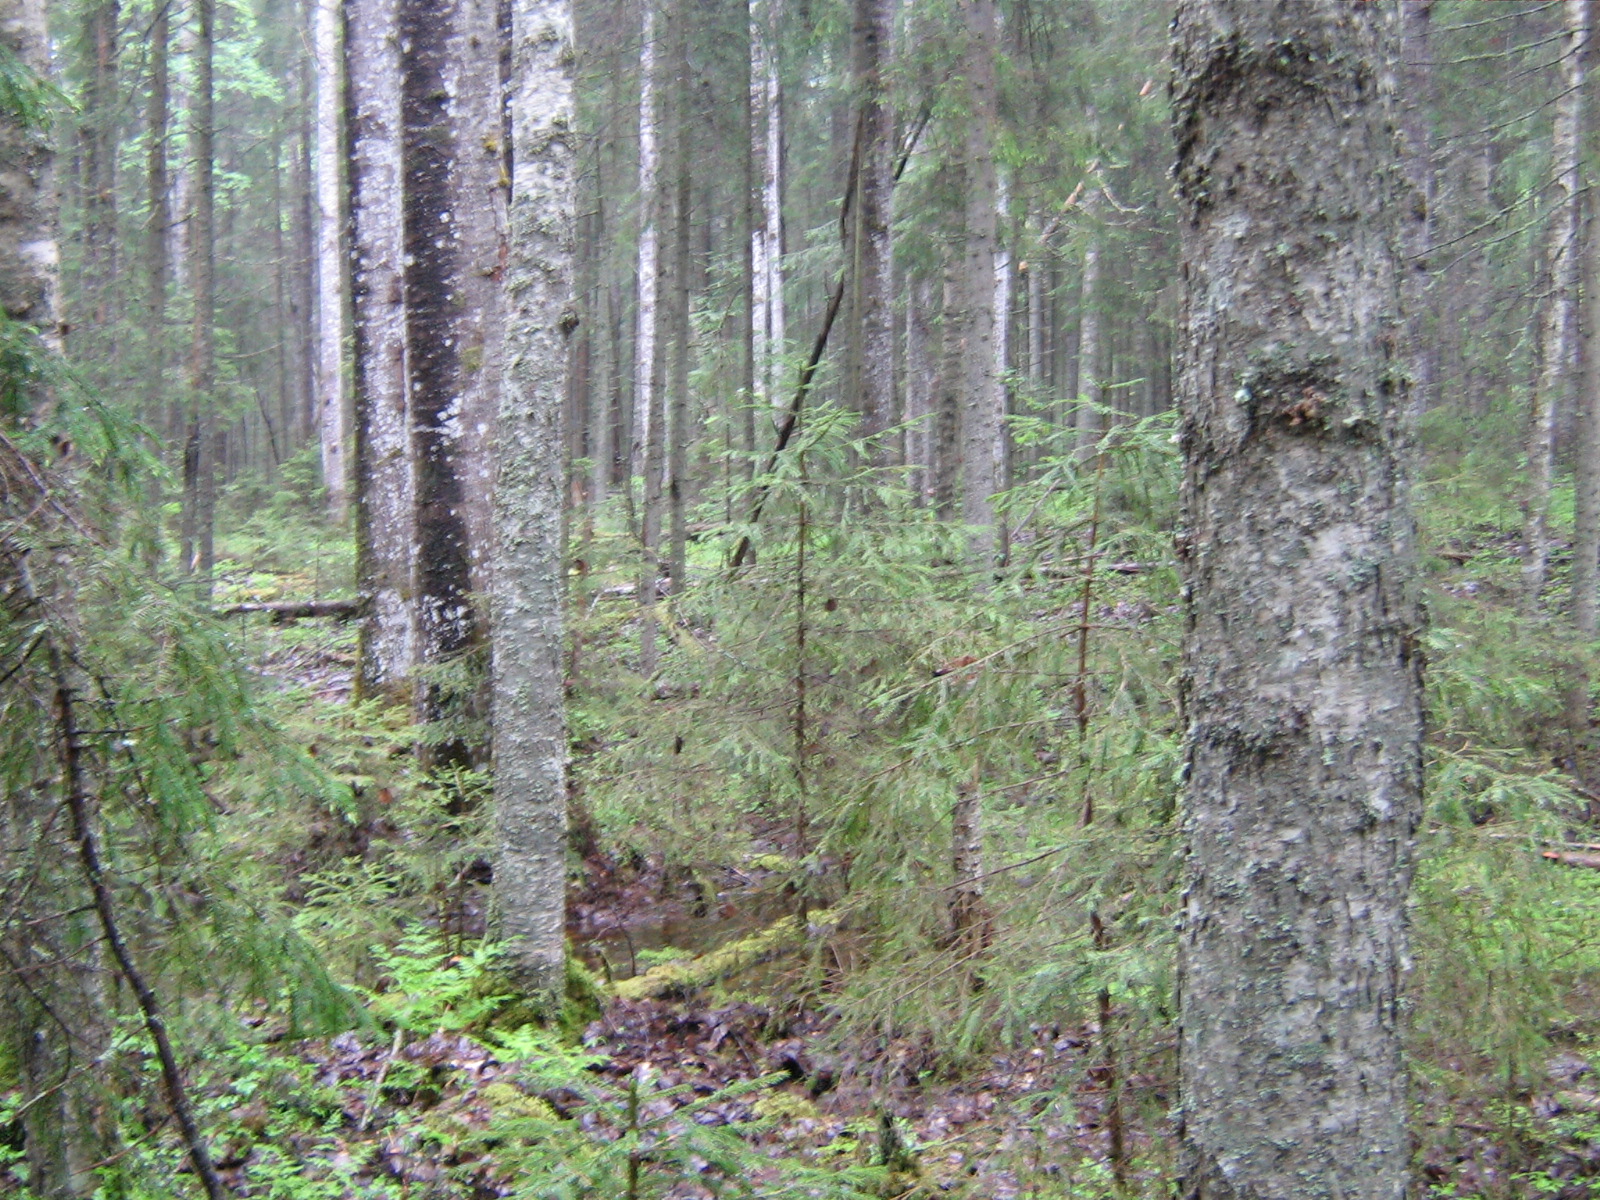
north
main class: Woodland
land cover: Spruce dominated mixed woodland
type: boreal forest
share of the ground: > 75 %
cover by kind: coniferous forest trees 75 %, broadleaved forest trees 25 %
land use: Forestry
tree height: > 5 m
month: May
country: LV
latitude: 57.2912
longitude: 25.9747
